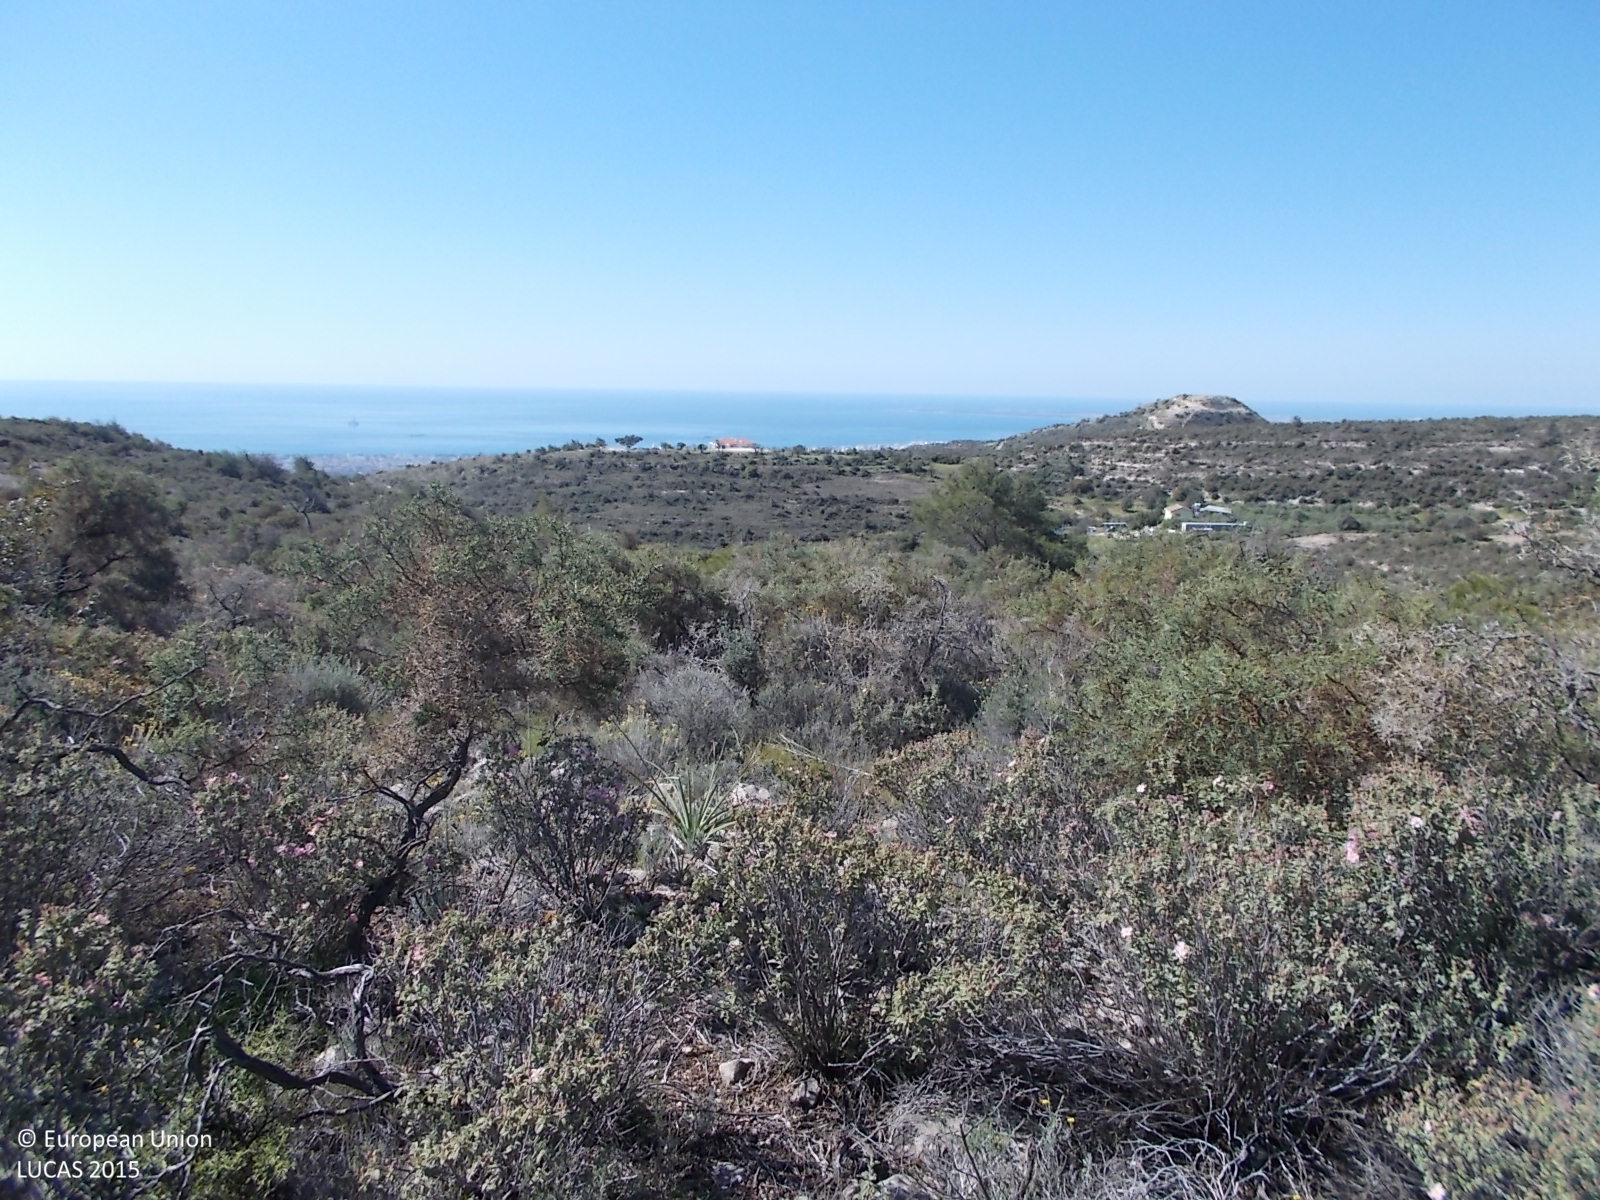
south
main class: Shrubland
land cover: Shrubland without tree cover
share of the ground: > 75 %
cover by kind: shrubs 100 %
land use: Semi-natural and natural areas not in use
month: April
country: CY
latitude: 34.7609
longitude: 33.0560
